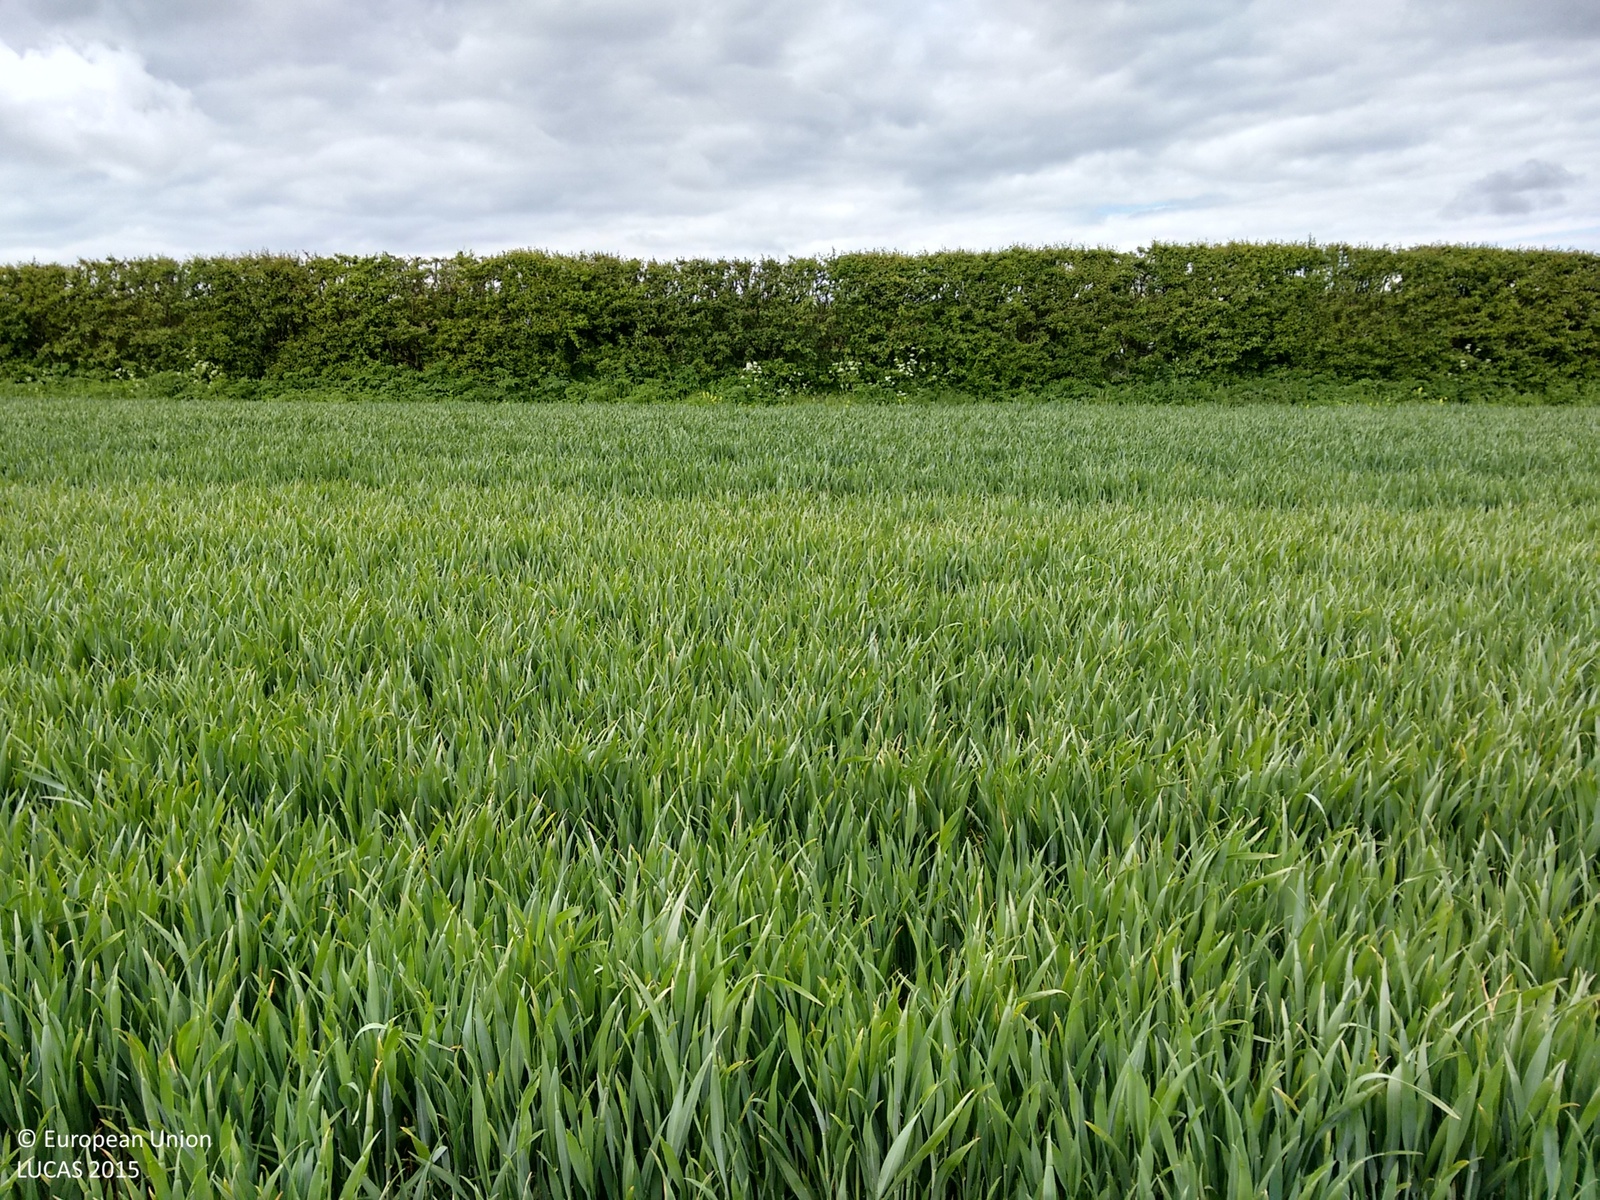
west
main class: Cropland
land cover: Common wheat
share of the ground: > 75 %
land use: Agriculture (excluding fallow land and kitchen gardens)
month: May
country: GB
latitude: 53.4773
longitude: -0.2044
